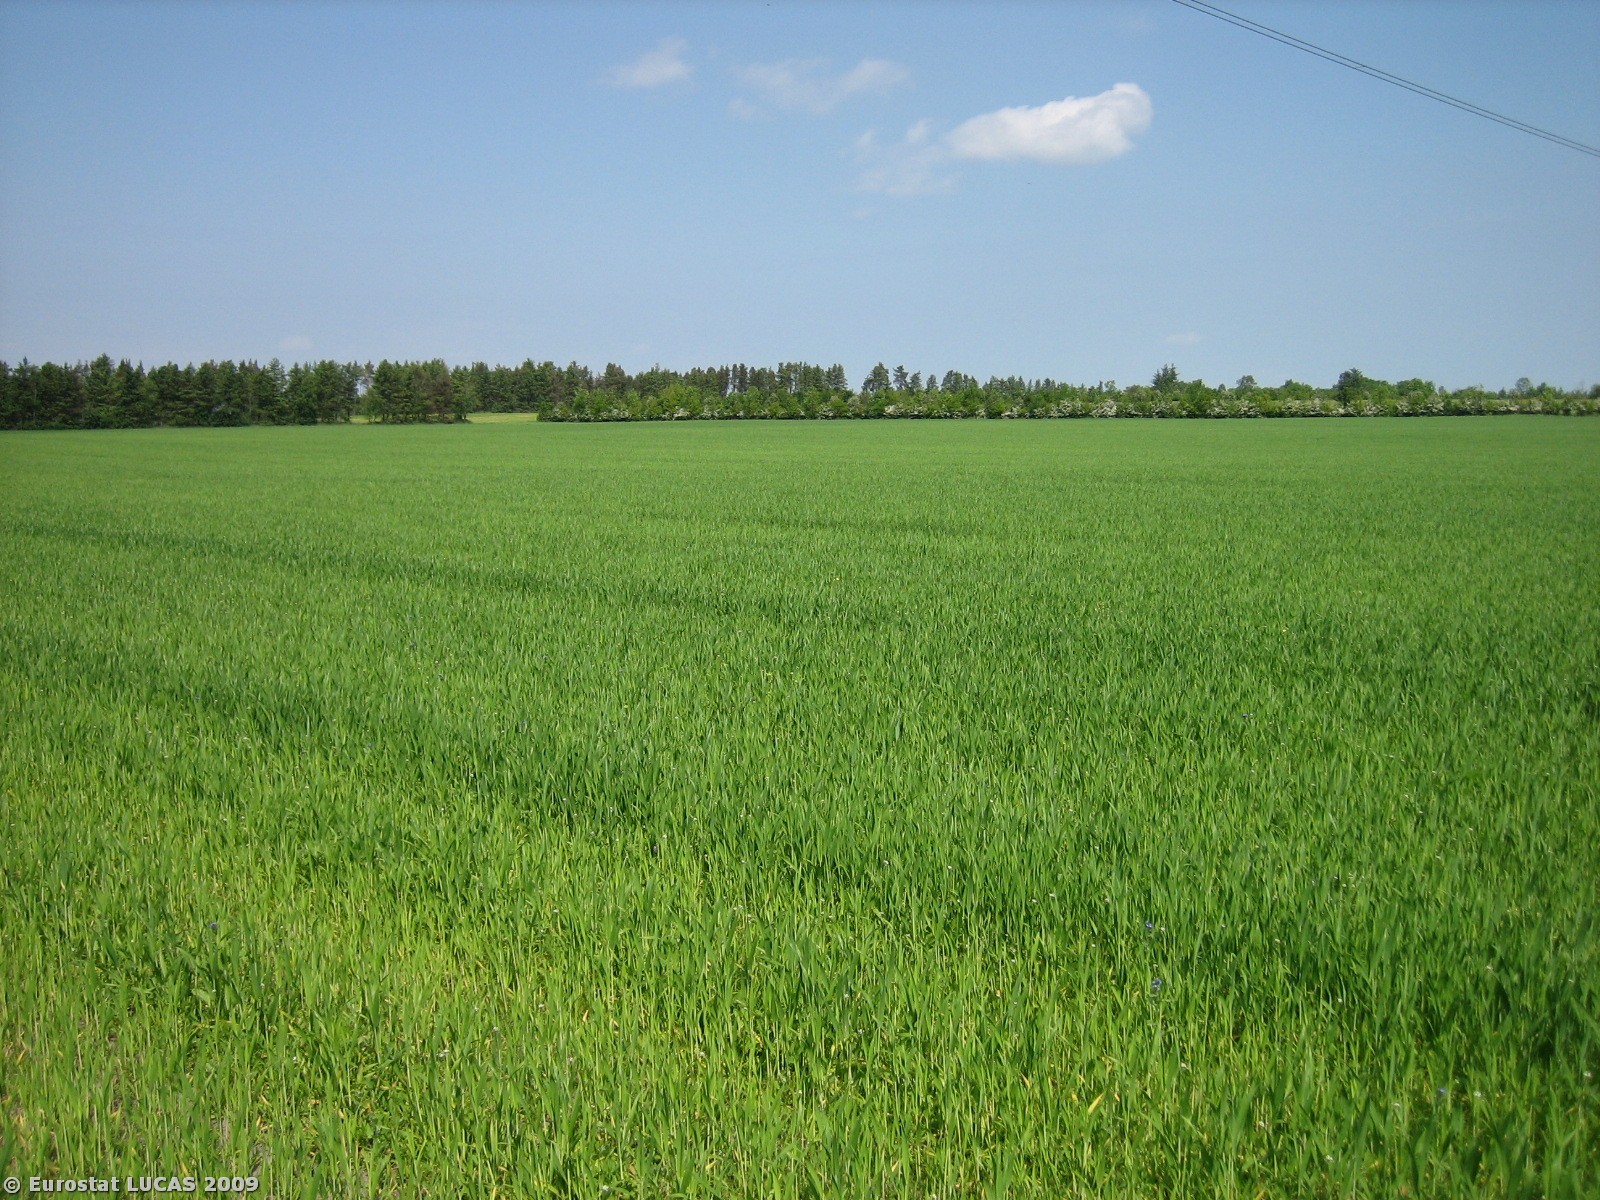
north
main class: Cropland
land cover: Barley
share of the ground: > 75 %
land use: Agriculture (excluding fallow land and kitchen gardens)
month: May
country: DK
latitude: 56.1138
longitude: 9.2771
